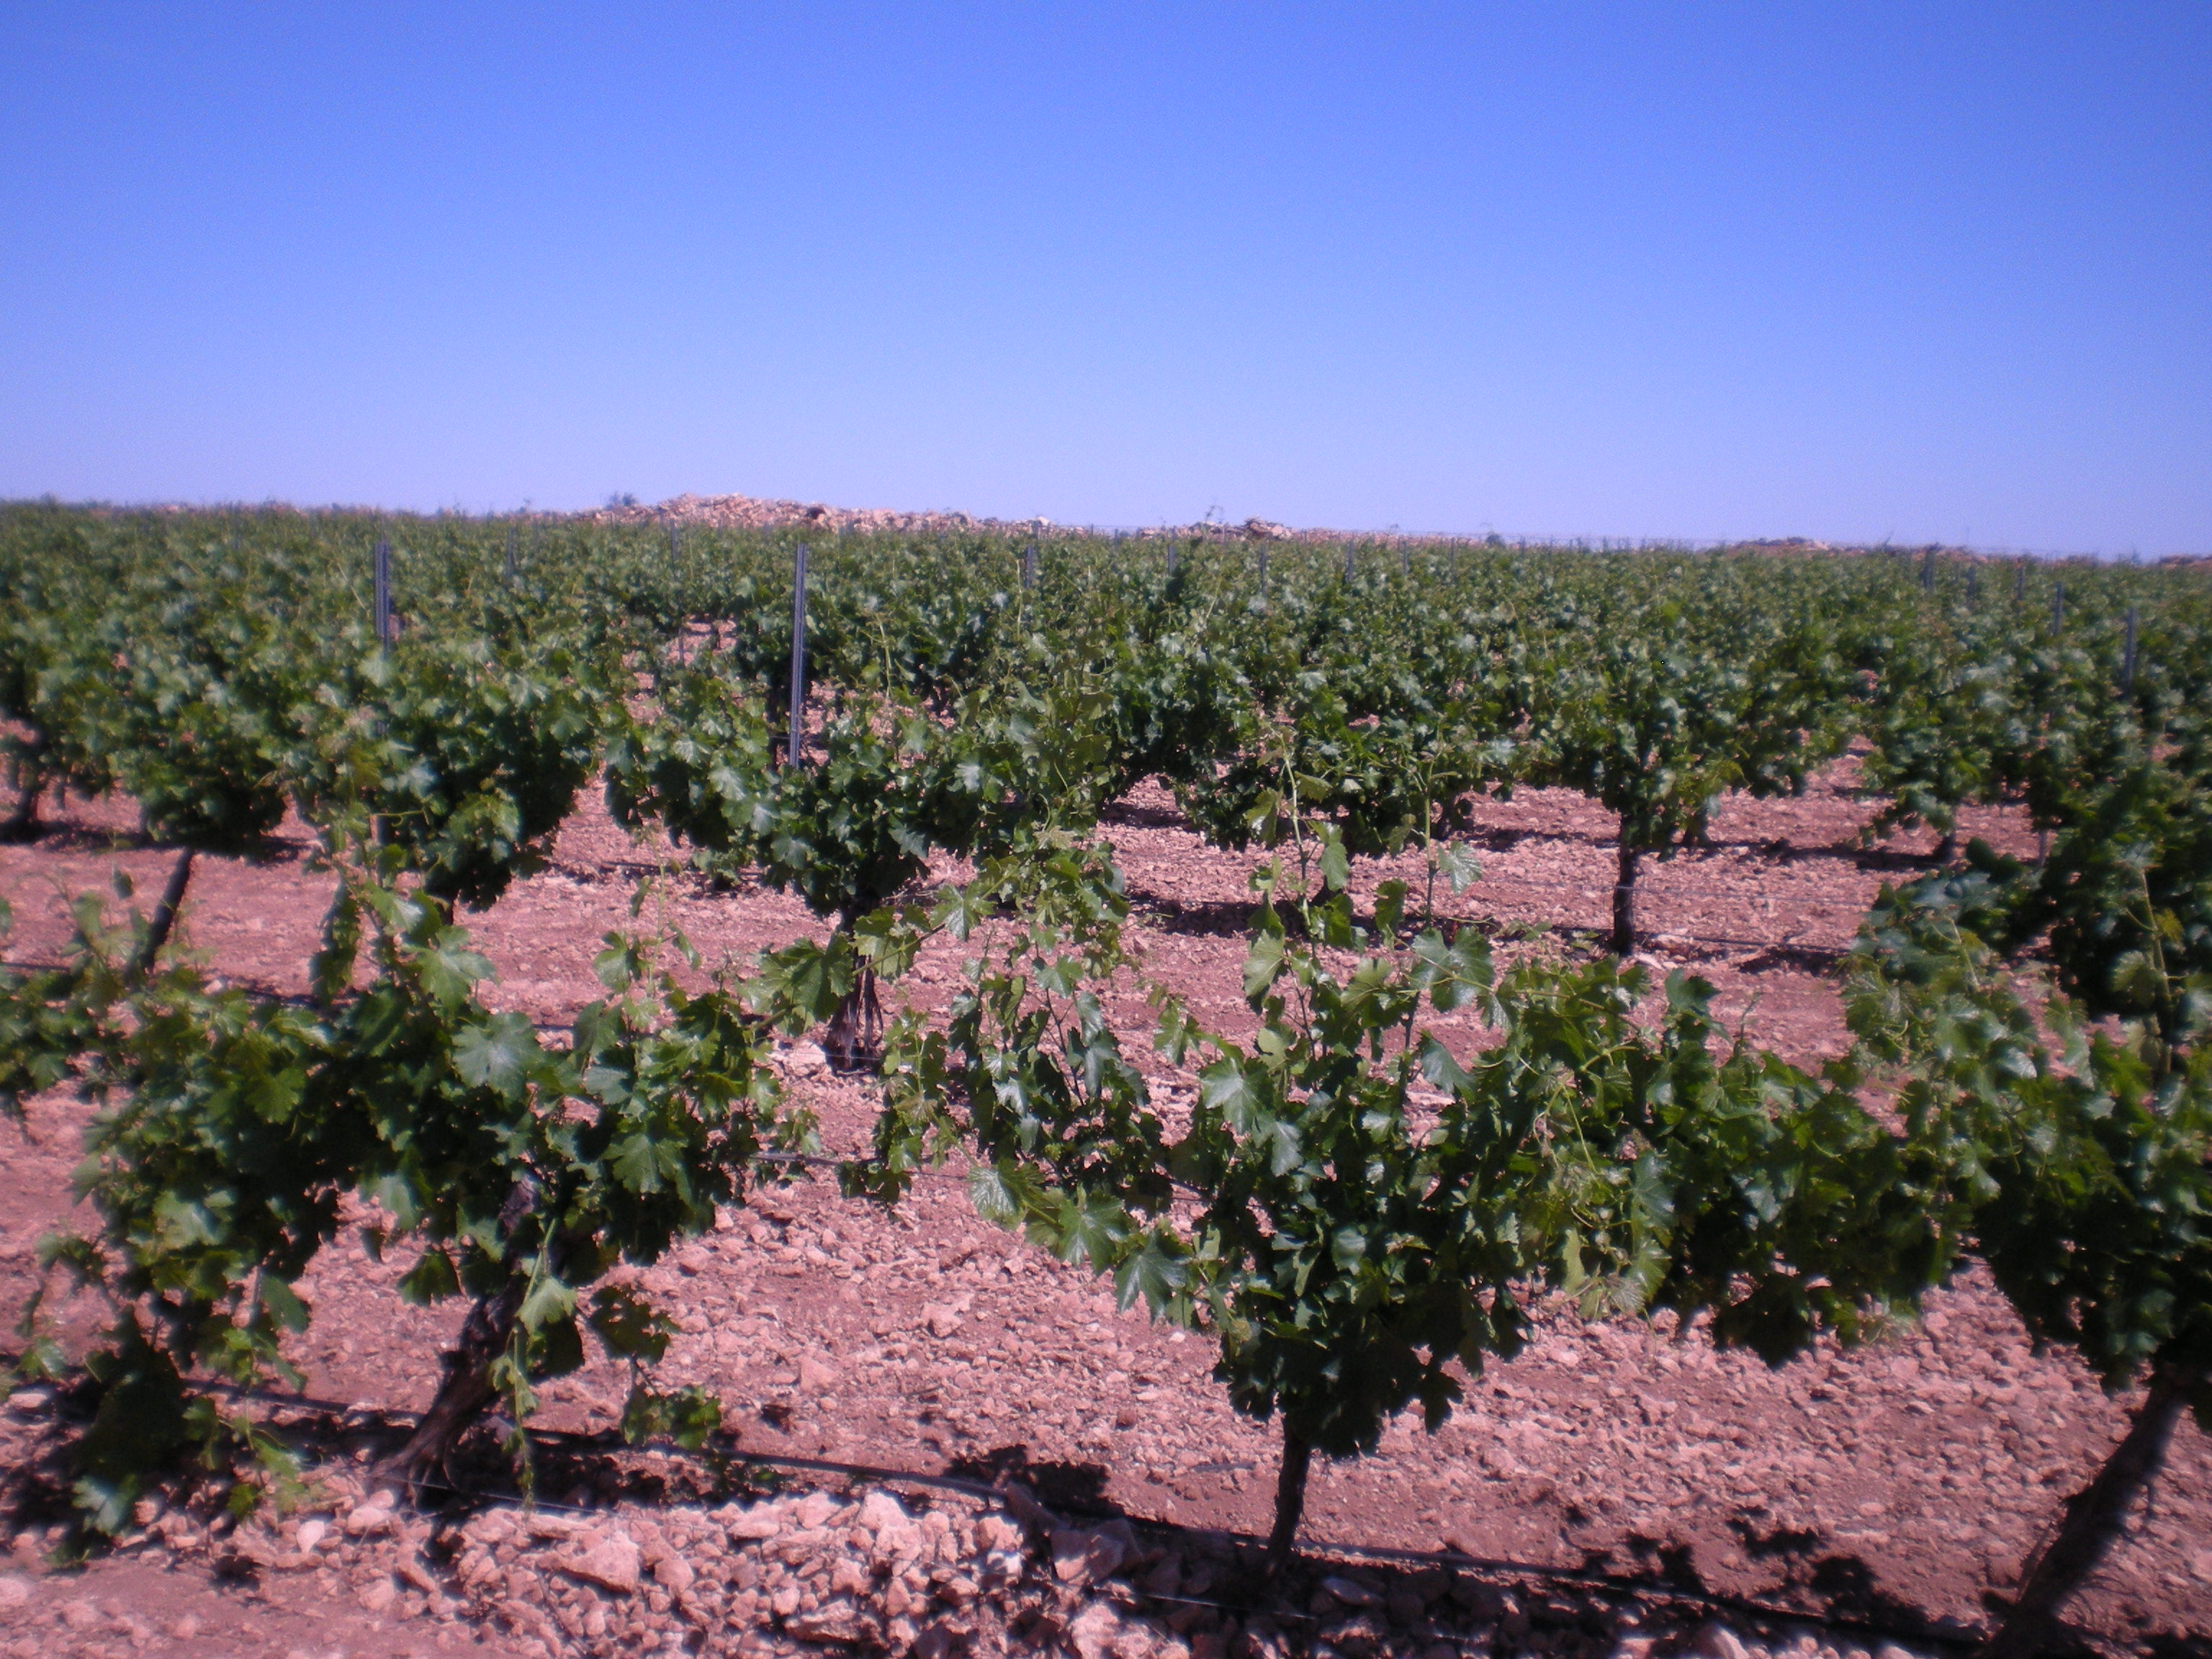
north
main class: Cropland
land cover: Vineyards
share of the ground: 10 - 25 %
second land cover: Other bare soil
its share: > 75 %
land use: Agriculture (excluding fallow land and kitchen gardens)
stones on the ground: 25 - 50 %
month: May
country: ES
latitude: 39.1428
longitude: -3.2627
